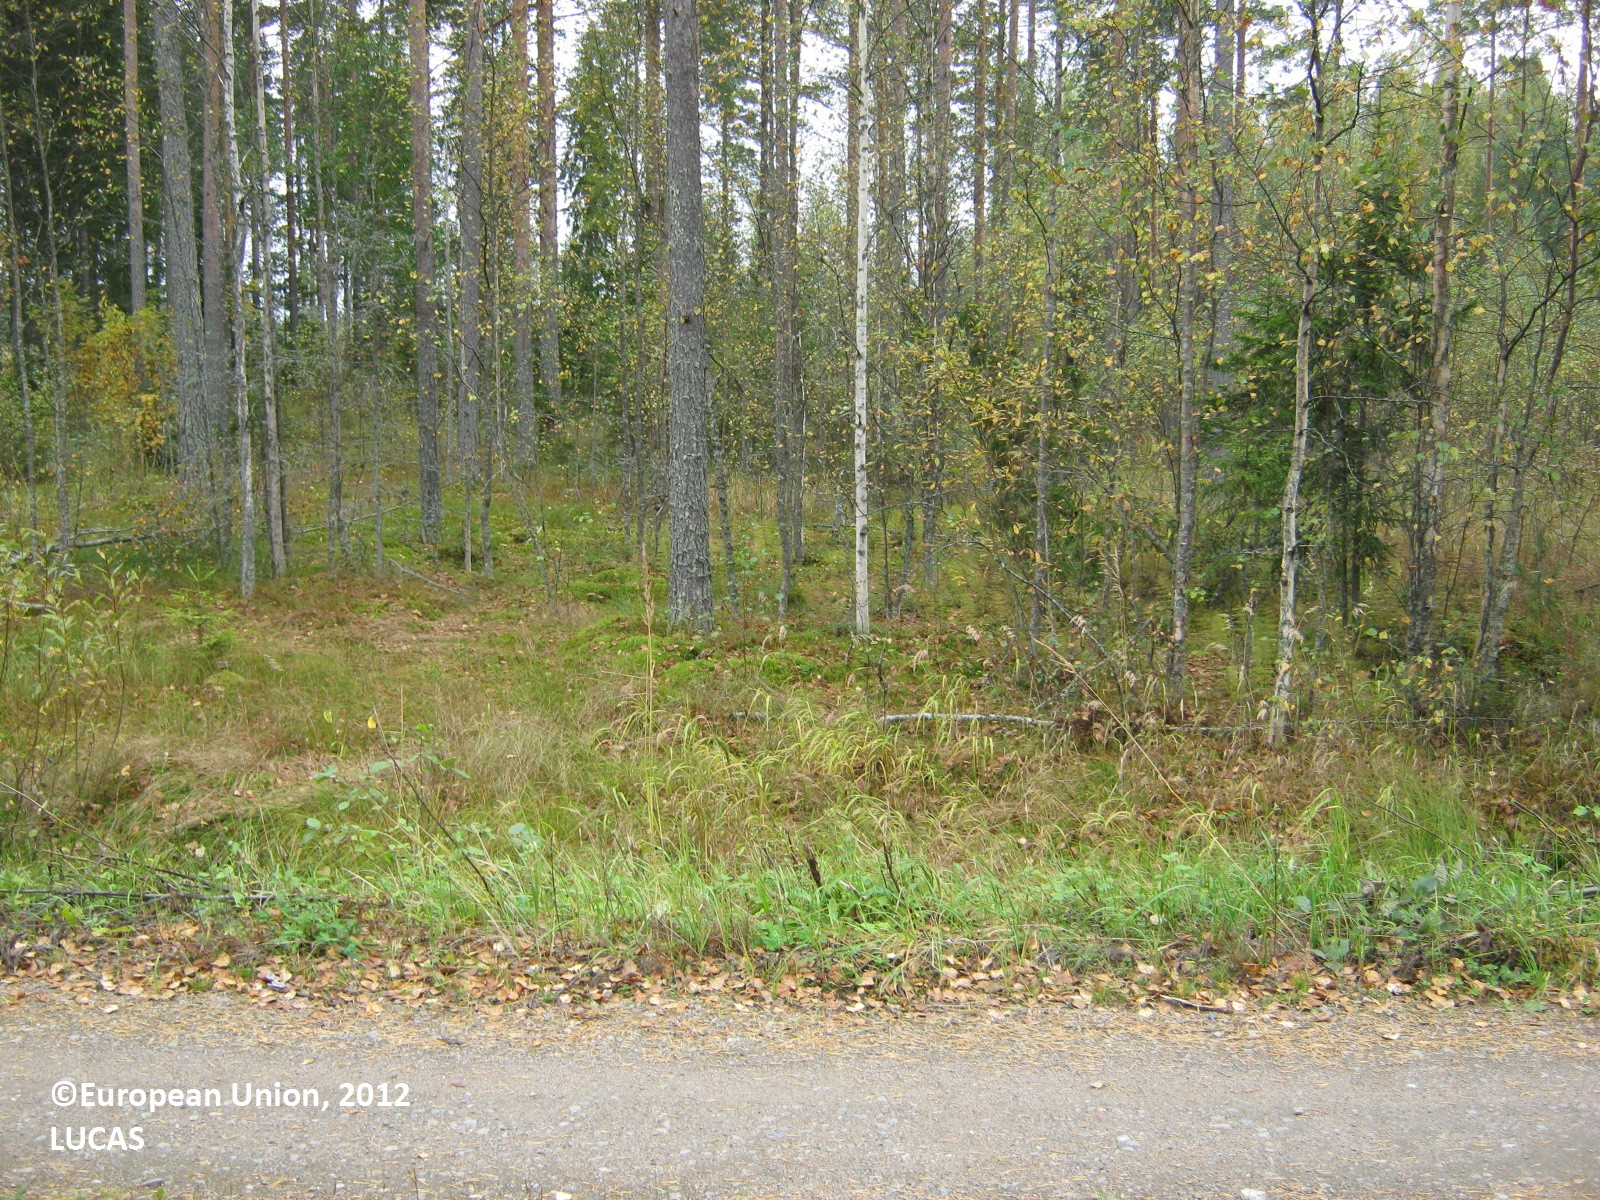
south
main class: Grassland
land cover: Spontaneously vegetated surfaces
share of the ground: > 75 %
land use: Railway transport
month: September
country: FI
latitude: 61.0175
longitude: 28.0925
